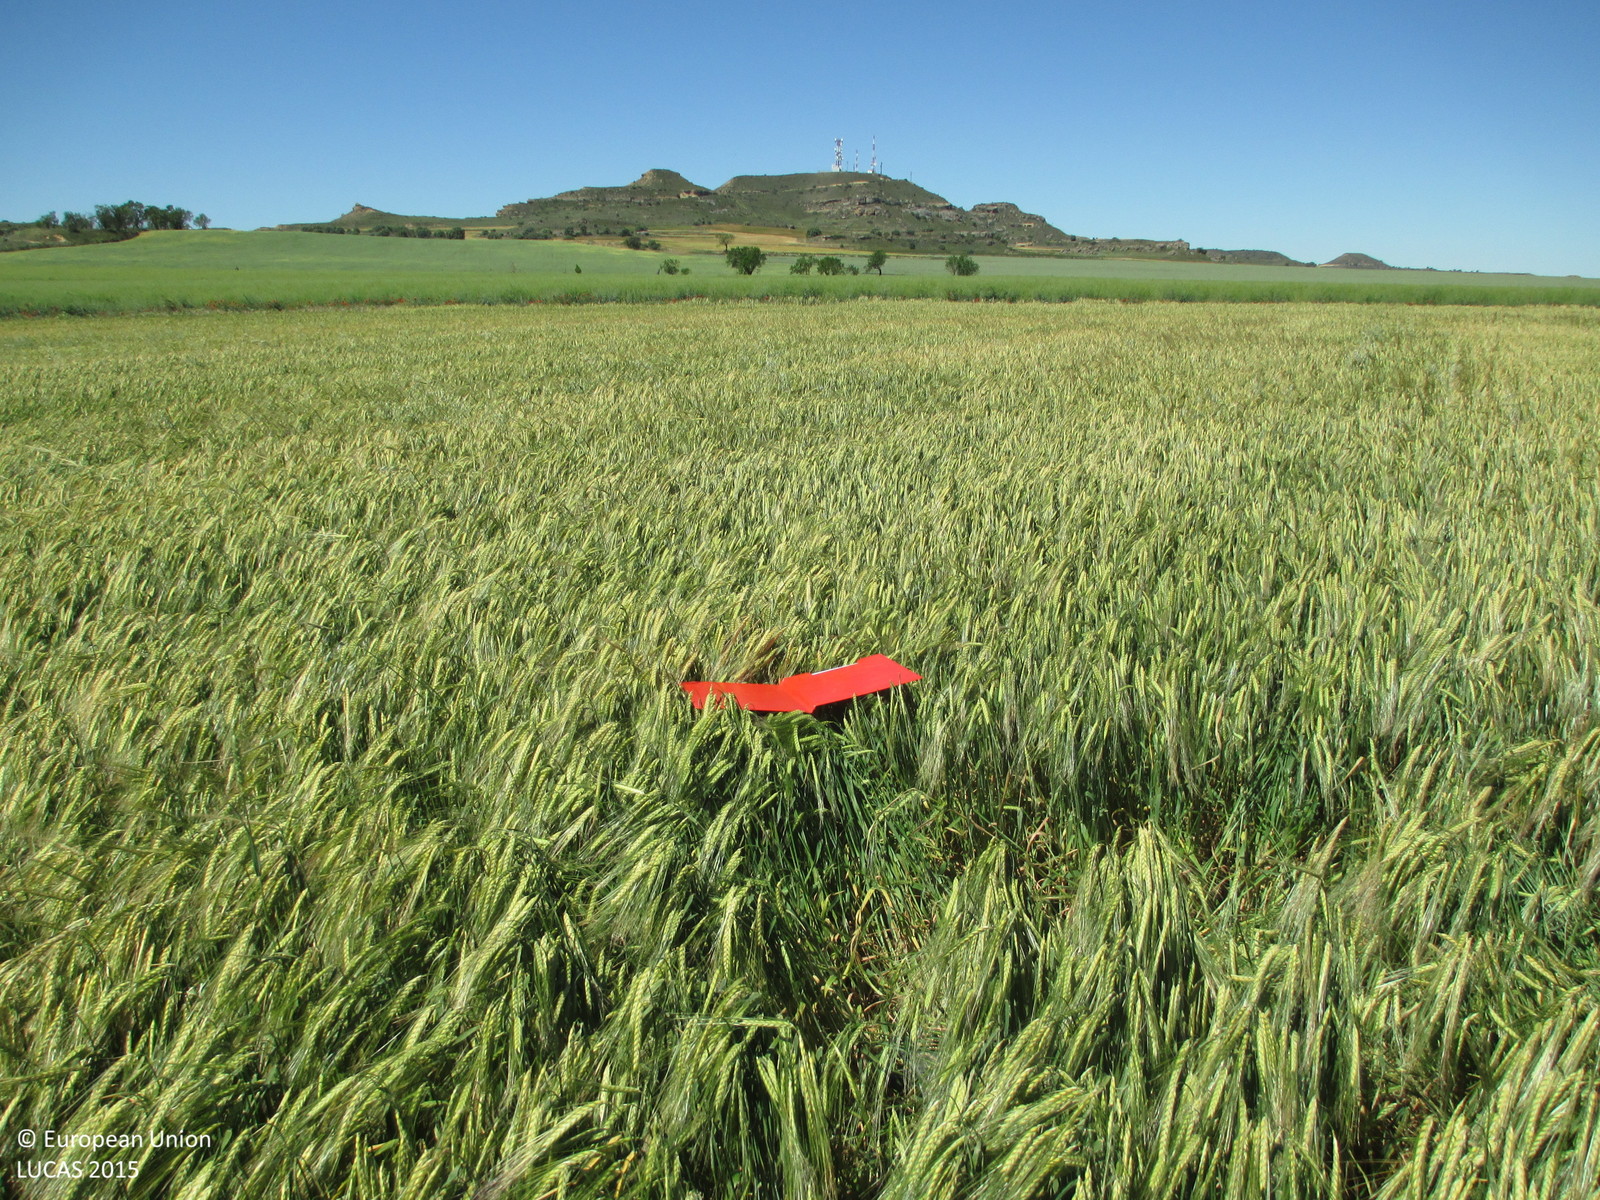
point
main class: Cropland
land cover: Barley
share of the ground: > 75 %
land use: Agriculture (excluding fallow land and kitchen gardens)
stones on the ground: < 10 %
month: May
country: ES
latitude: 42.0186
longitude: -0.2977
